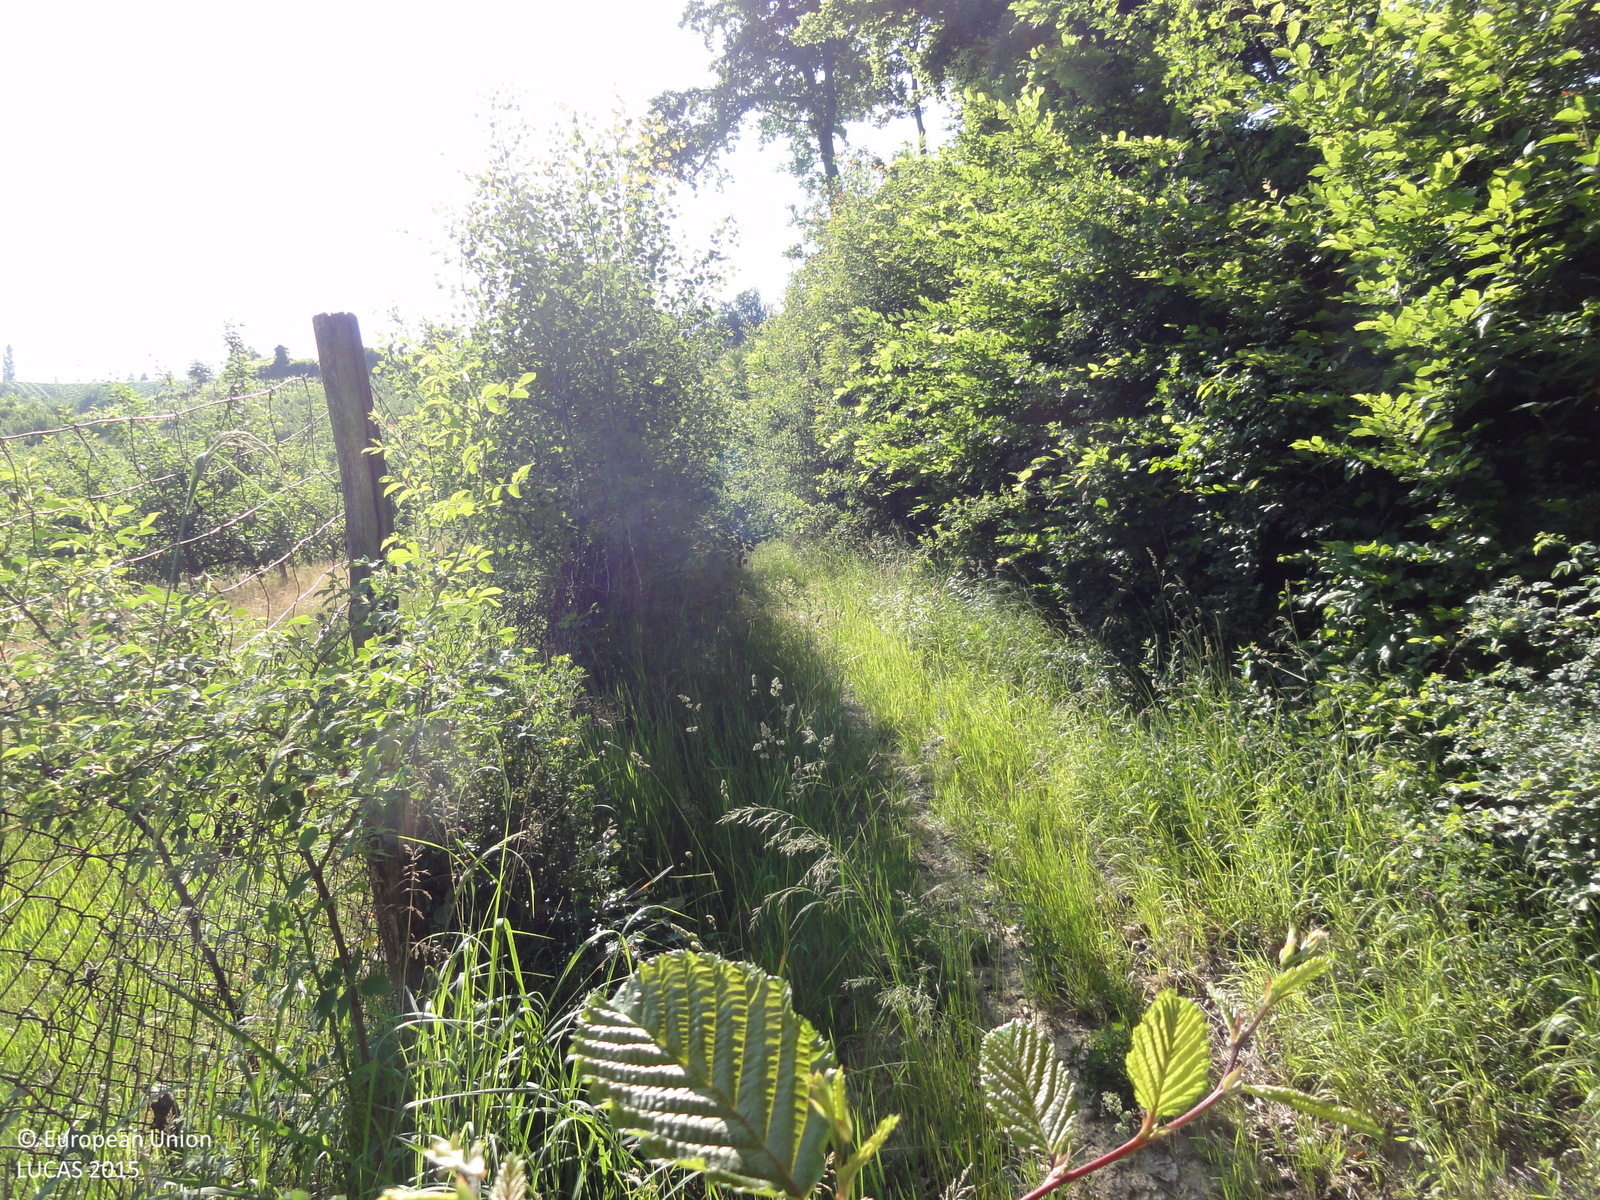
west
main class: Cropland
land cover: Apple fruit
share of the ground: > 75 %
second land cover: Grassland without tree/shrub cover
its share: > 75 %
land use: Agriculture (excluding fallow land and kitchen gardens)
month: June
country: SI
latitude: 46.4447
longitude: 16.1571
